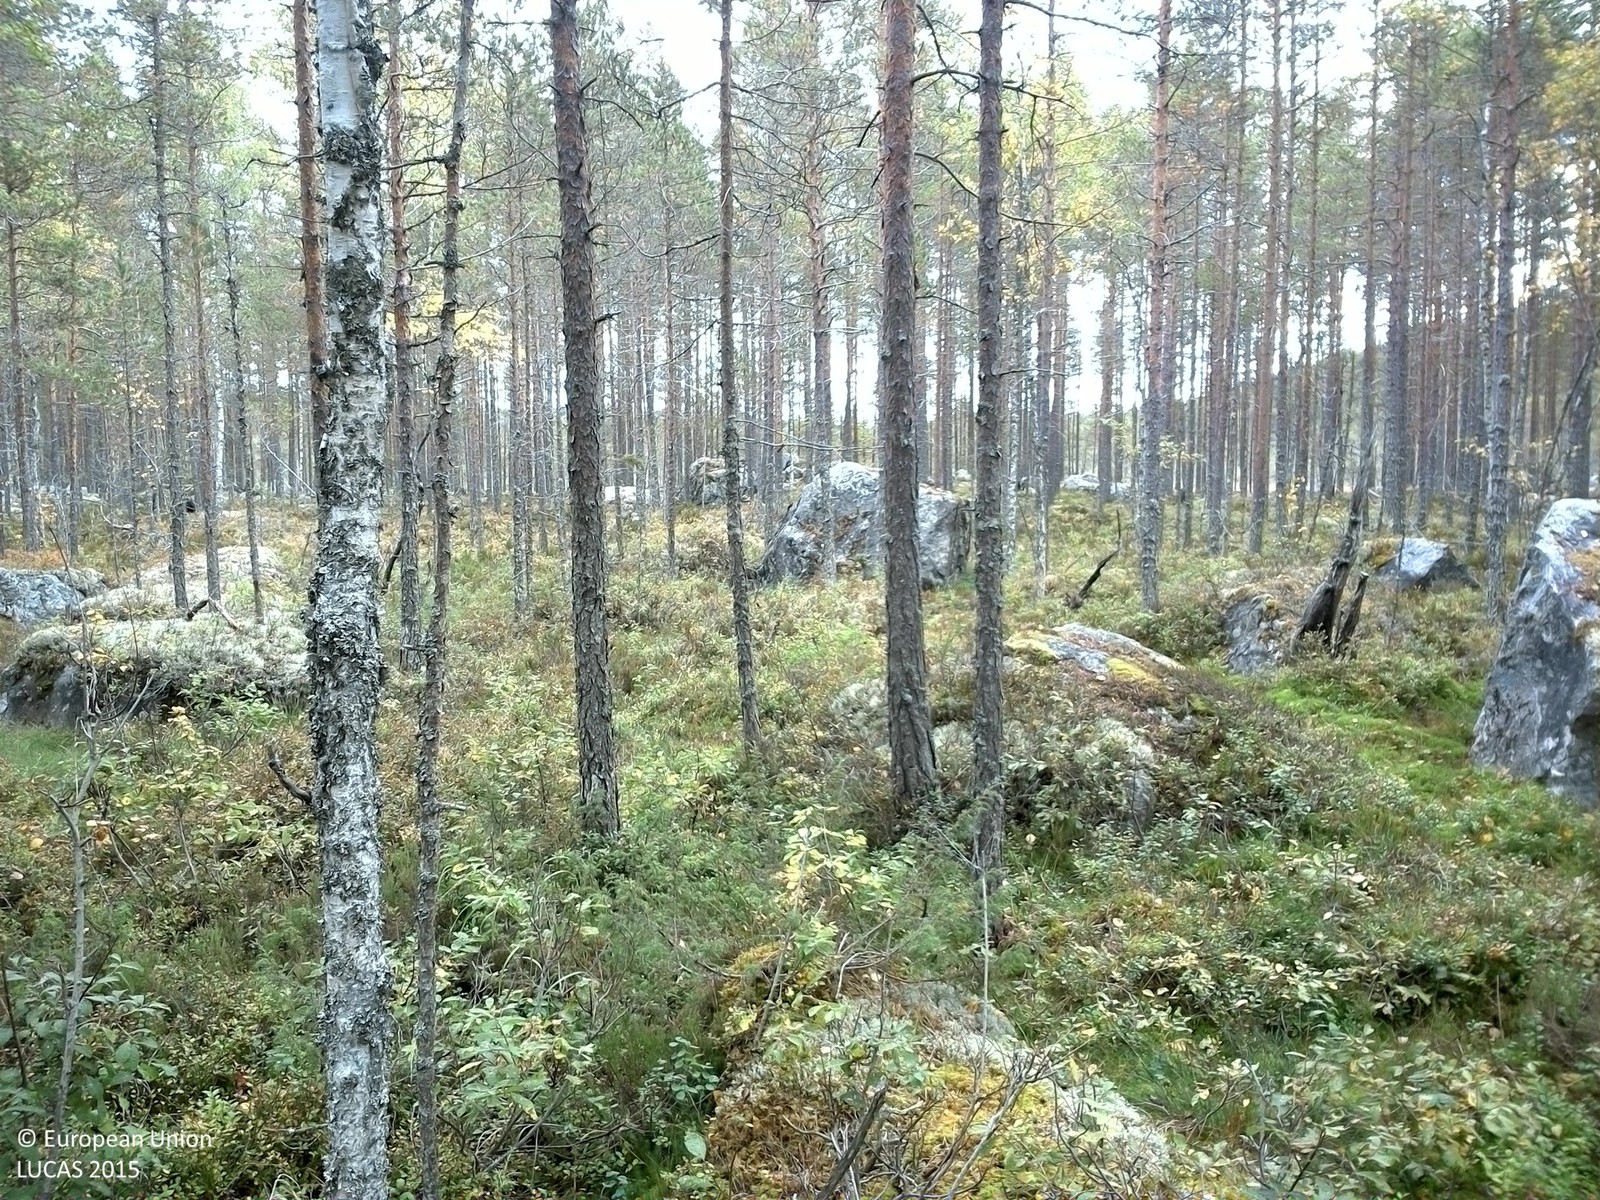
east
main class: Woodland
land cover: Pine dominated mixed woodland
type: boreal forest
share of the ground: 50 - 75 %
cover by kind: coniferous forest trees 45 %, broadleaved forest trees 25 %, shrubs 20 %, lichens and mosses 5 %, consolidated bare surface 5 %
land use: Forestry
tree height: > 5 m
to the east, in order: Pine dominated mixed woodland; Pine dominated coniferous woodland; Peatbogs
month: September
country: SE
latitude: 61.2712
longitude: 15.3375
